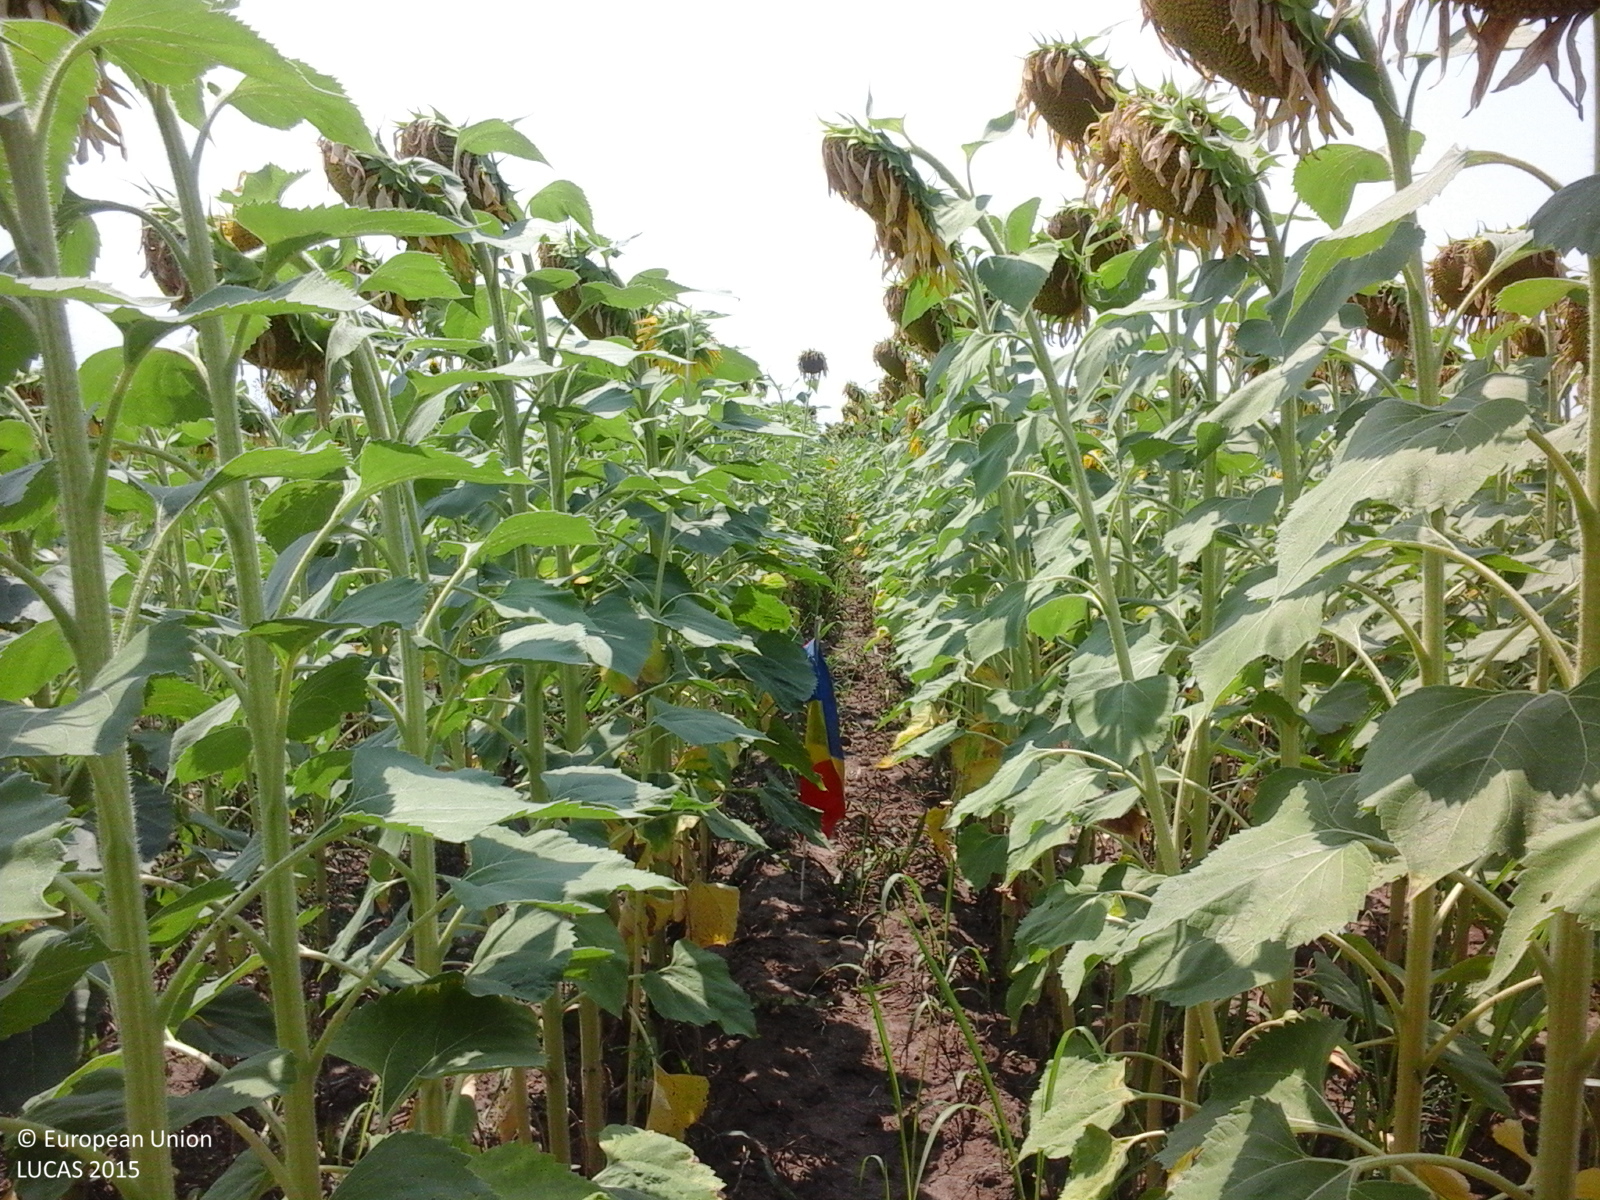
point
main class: Cropland
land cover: Sunflower
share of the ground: > 75 %
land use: Agriculture (excluding fallow land and kitchen gardens)
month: July
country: RO
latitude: 44.6602
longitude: 26.5774
